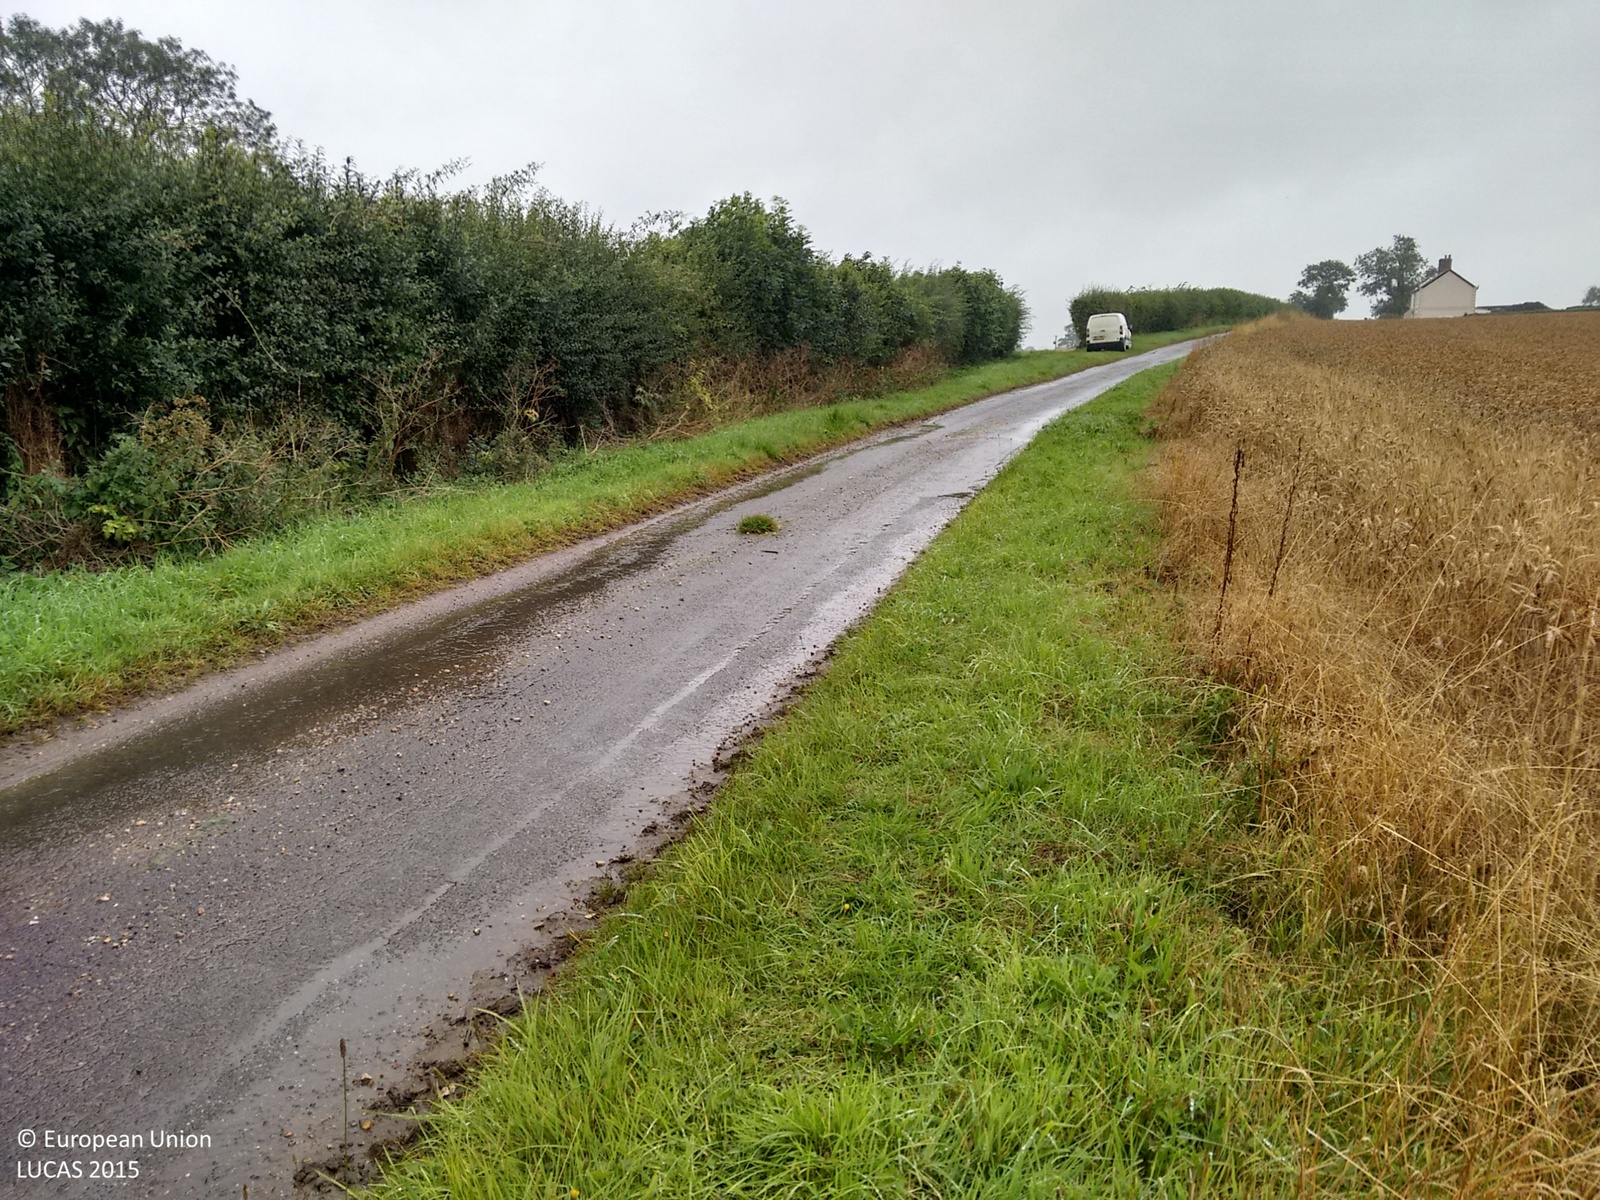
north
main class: Cropland
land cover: Common wheat
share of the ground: > 75 %
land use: Agriculture (excluding fallow land and kitchen gardens)
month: August
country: GB
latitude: 52.8152
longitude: 0.7911
